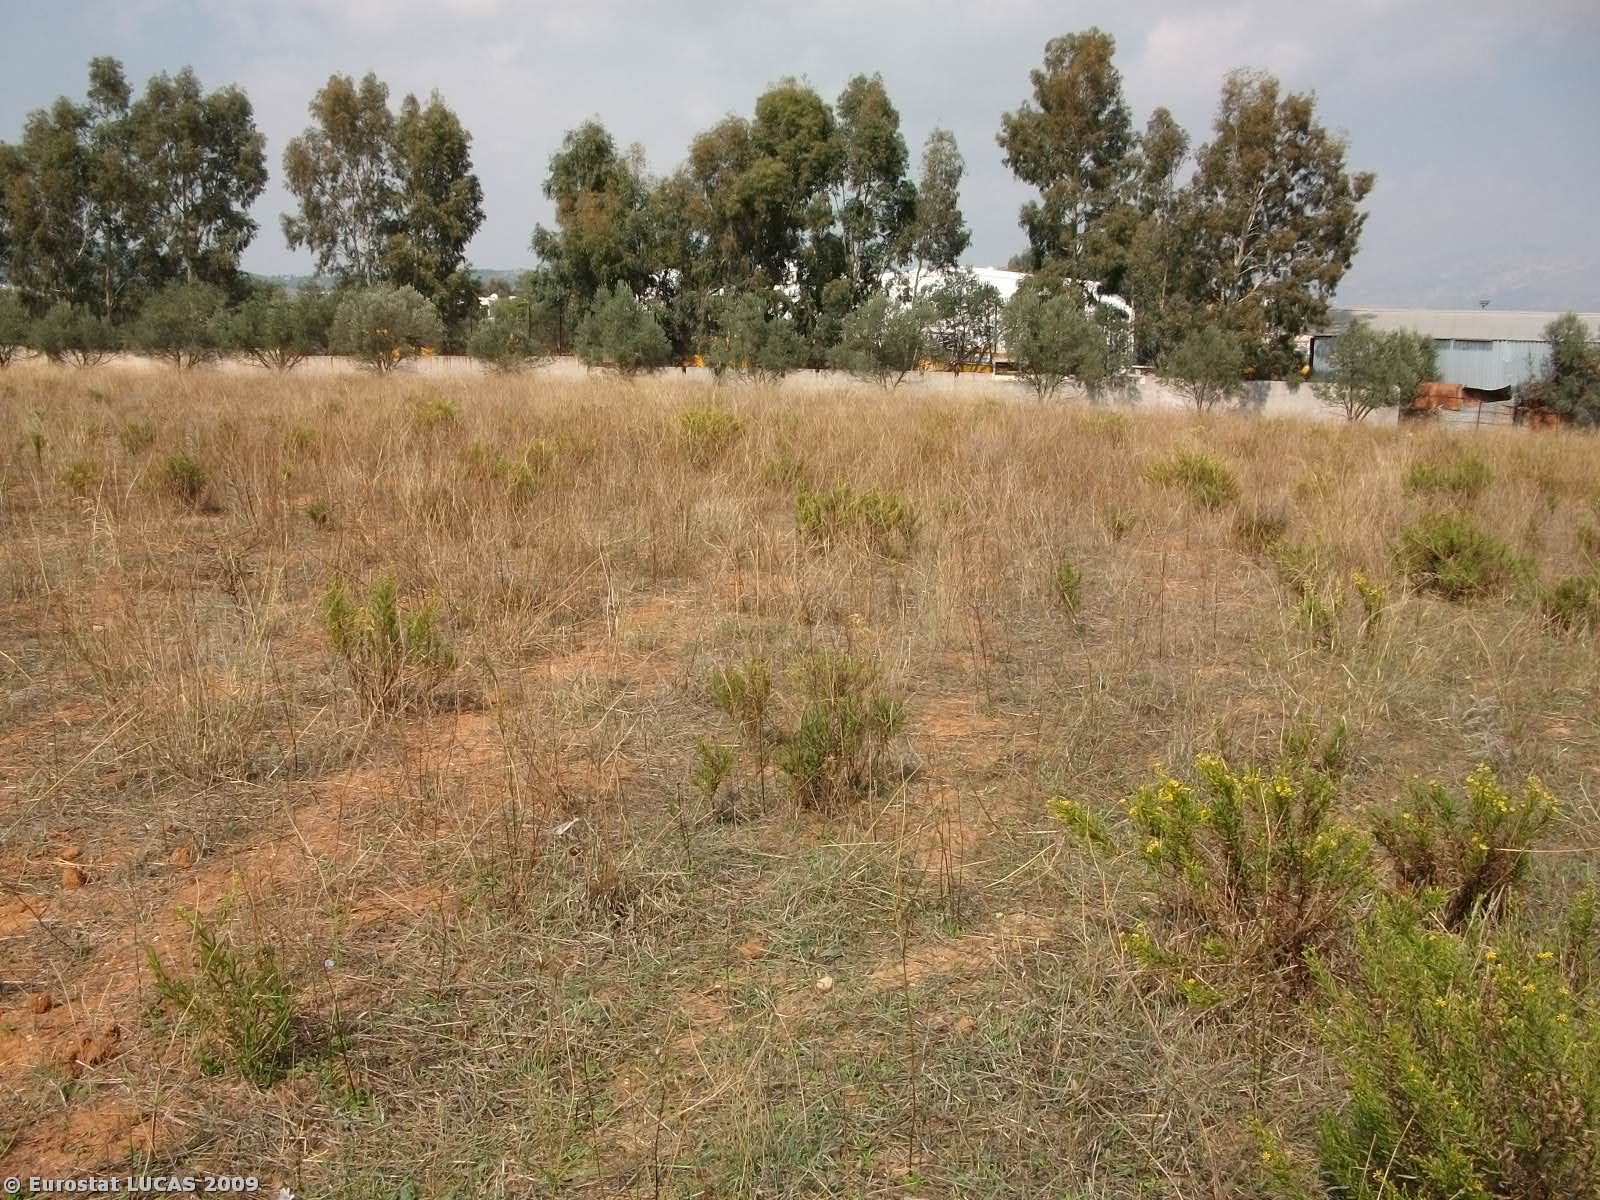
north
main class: Grassland
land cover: Grassland without tree/shrub cover
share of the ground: 50 - 75 %
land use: Agriculture (excluding fallow land and kitchen gardens)
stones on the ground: < 10 %
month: October
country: GR
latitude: 37.9761
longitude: 23.8592
